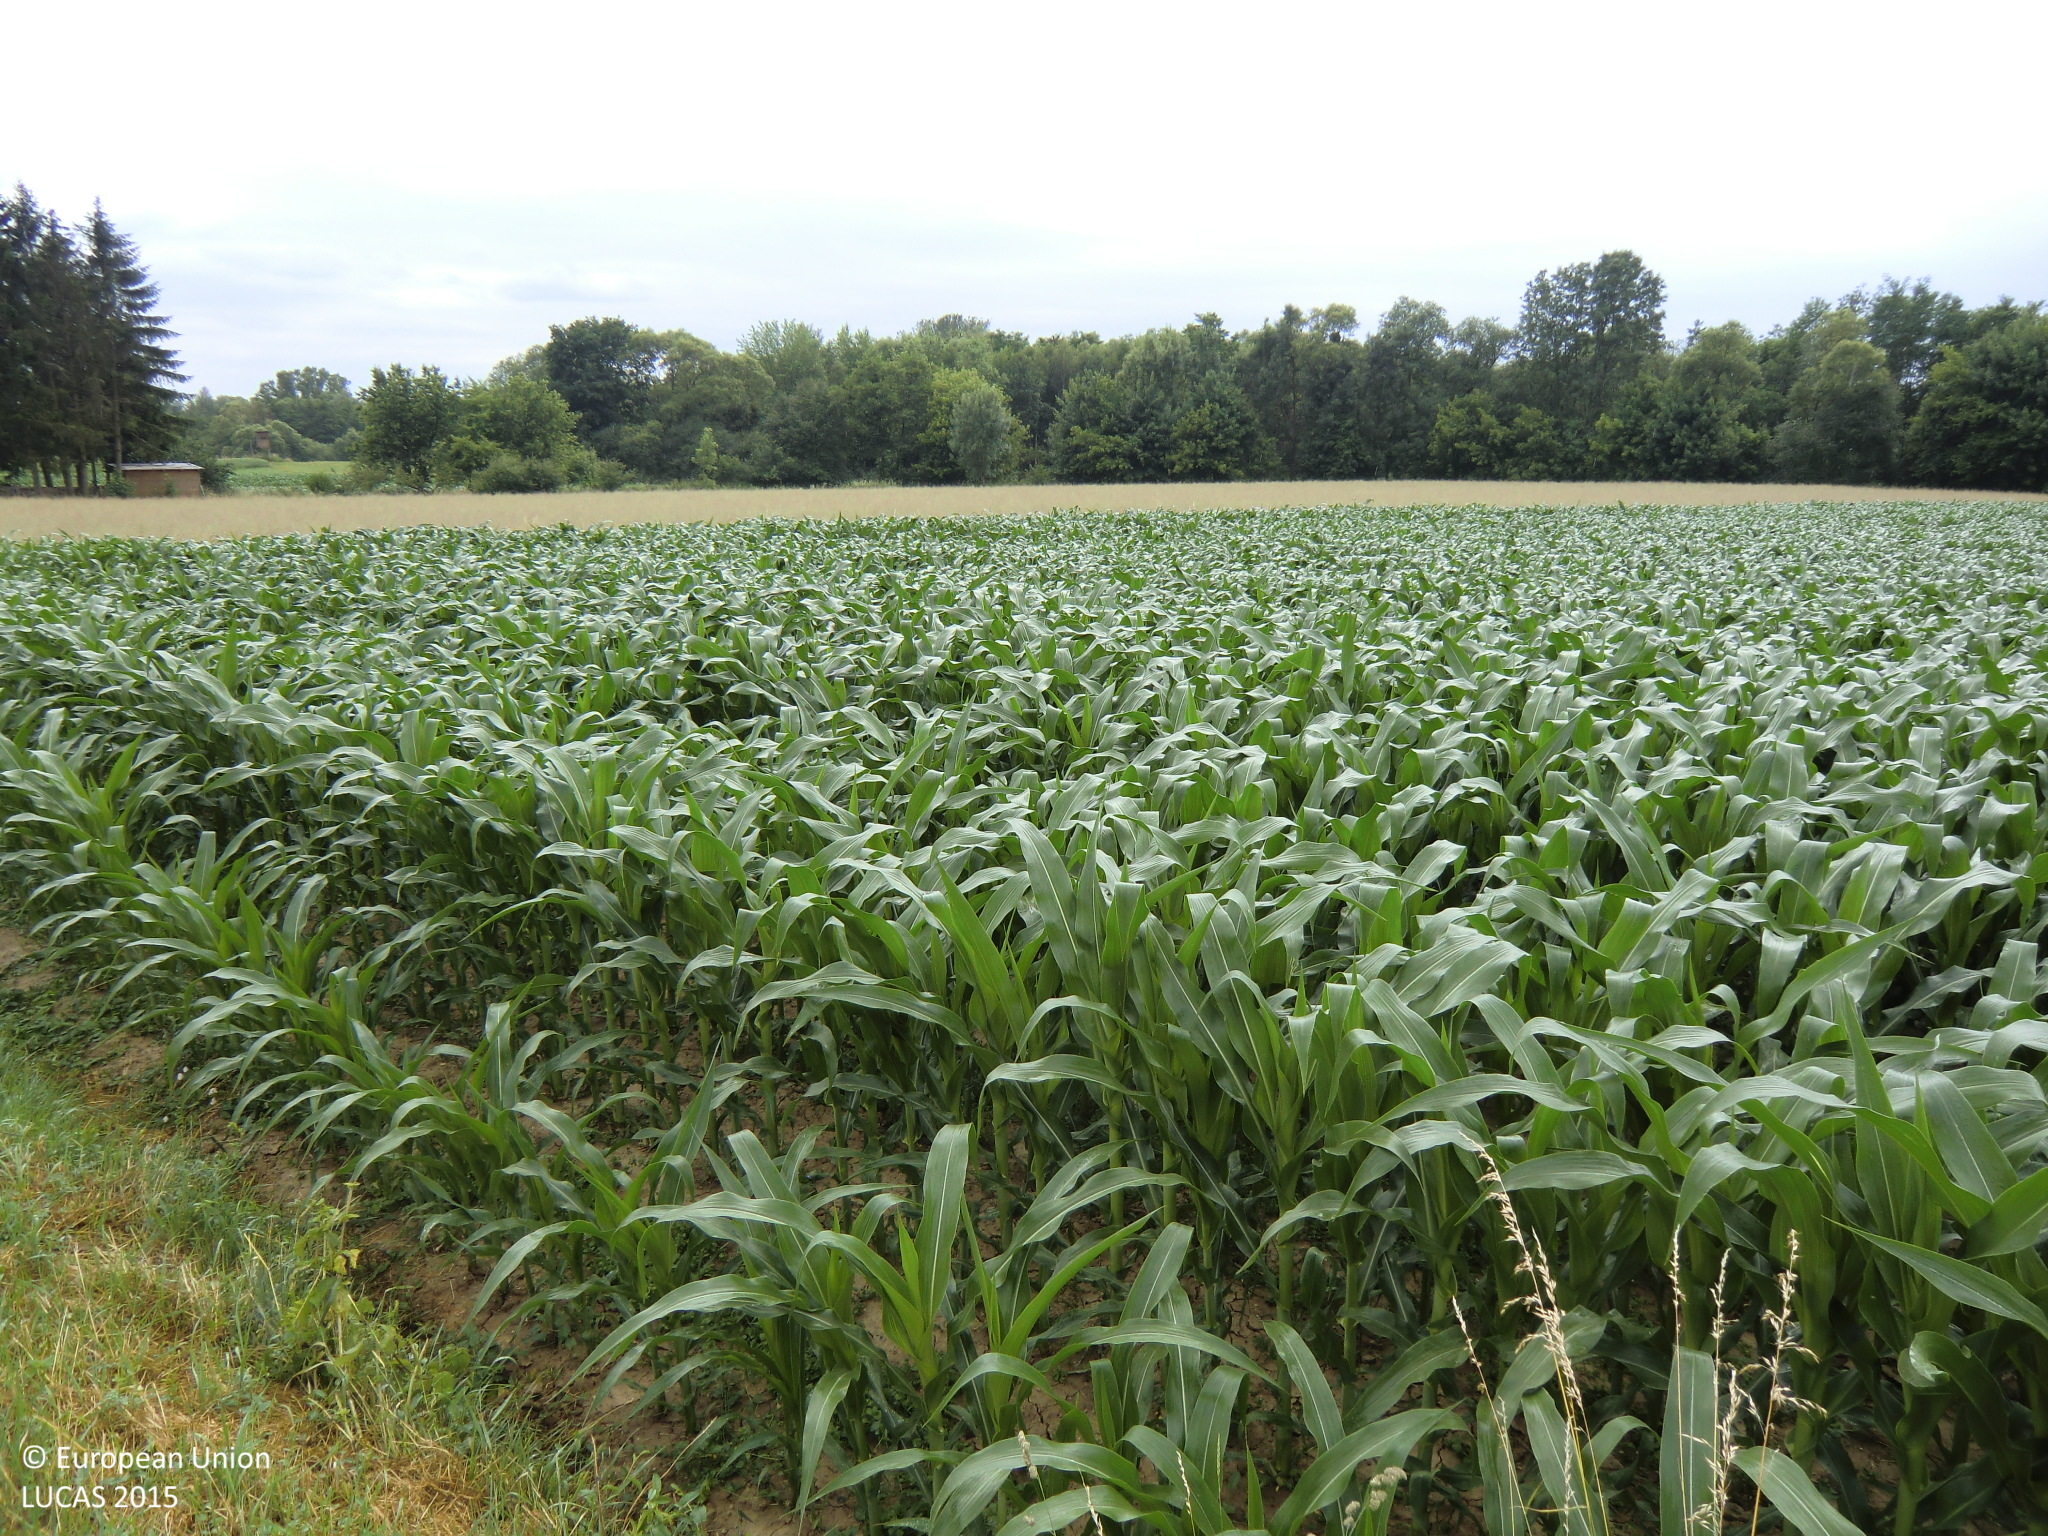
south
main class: Cropland
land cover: Maize
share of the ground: > 75 %
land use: Agriculture (excluding fallow land and kitchen gardens)
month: June
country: AT
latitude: 47.1697
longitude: 16.1100
